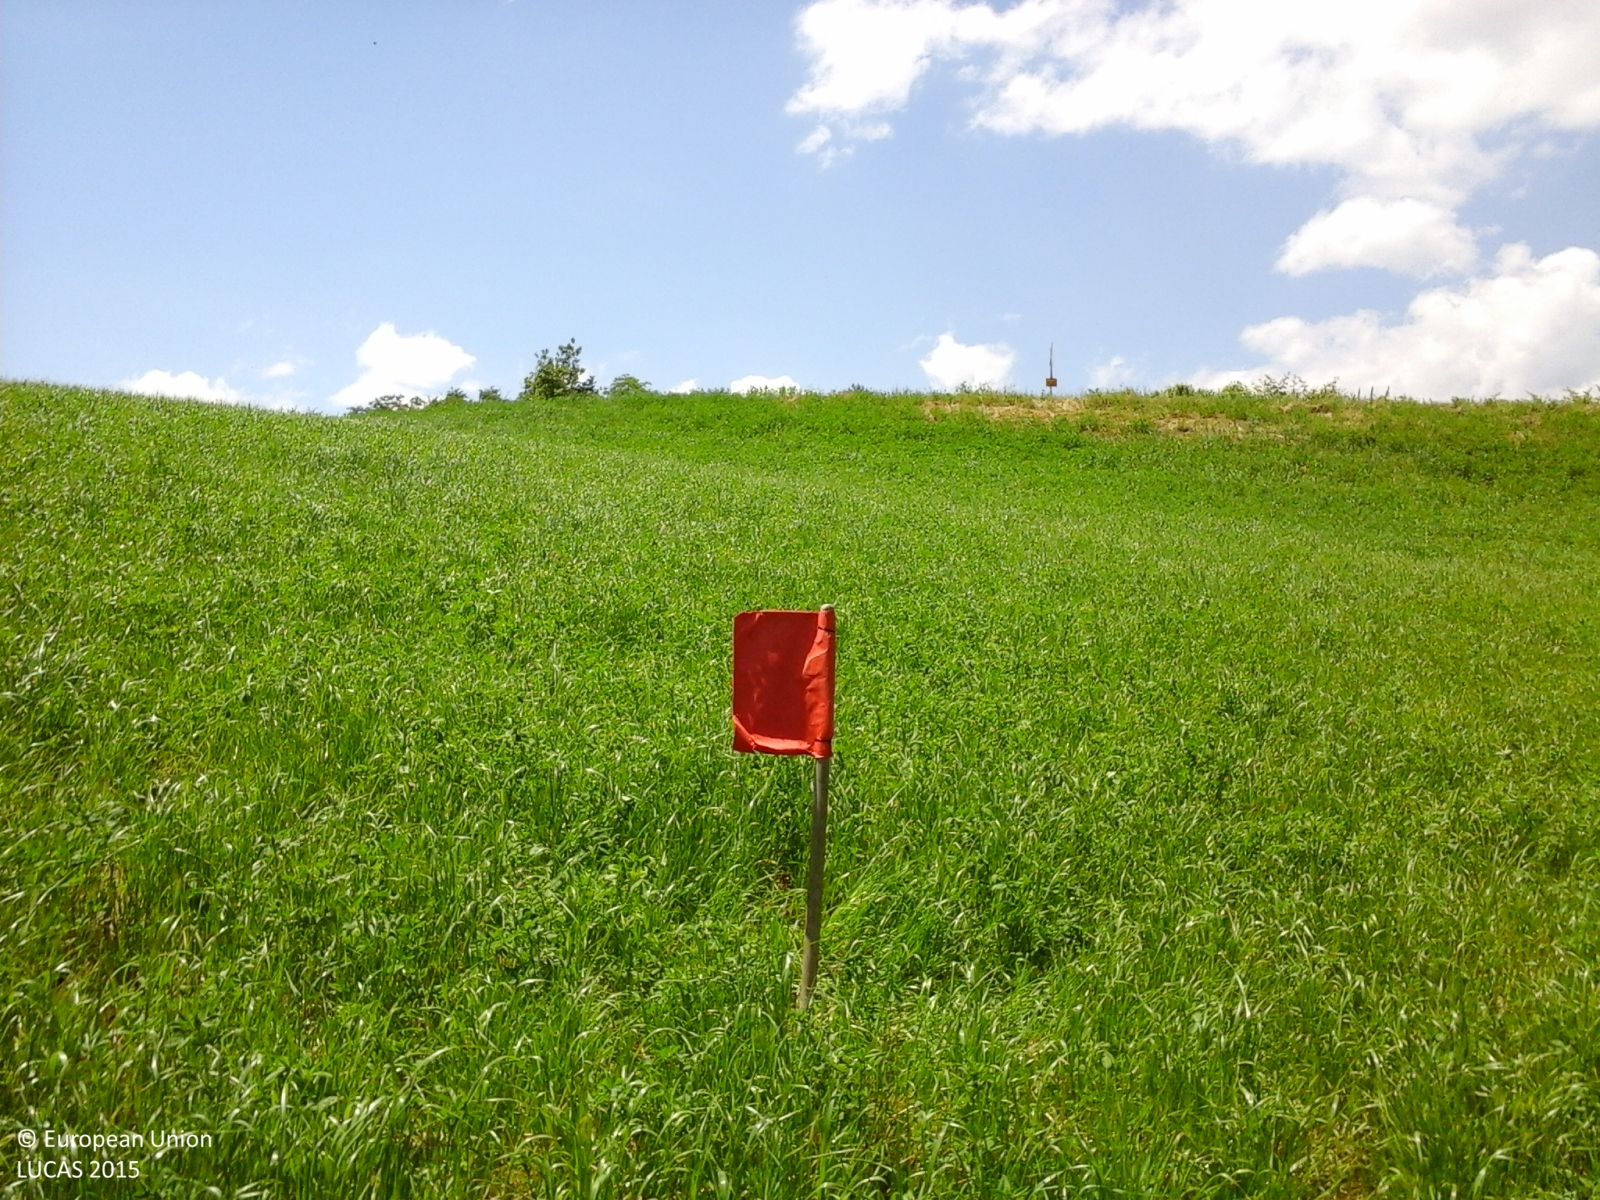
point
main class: Cropland
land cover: Lucerne
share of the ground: > 75 %
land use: Agriculture (excluding fallow land and kitchen gardens)
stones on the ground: < 10 %
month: May
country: IT
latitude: 44.7292
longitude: 10.0630
